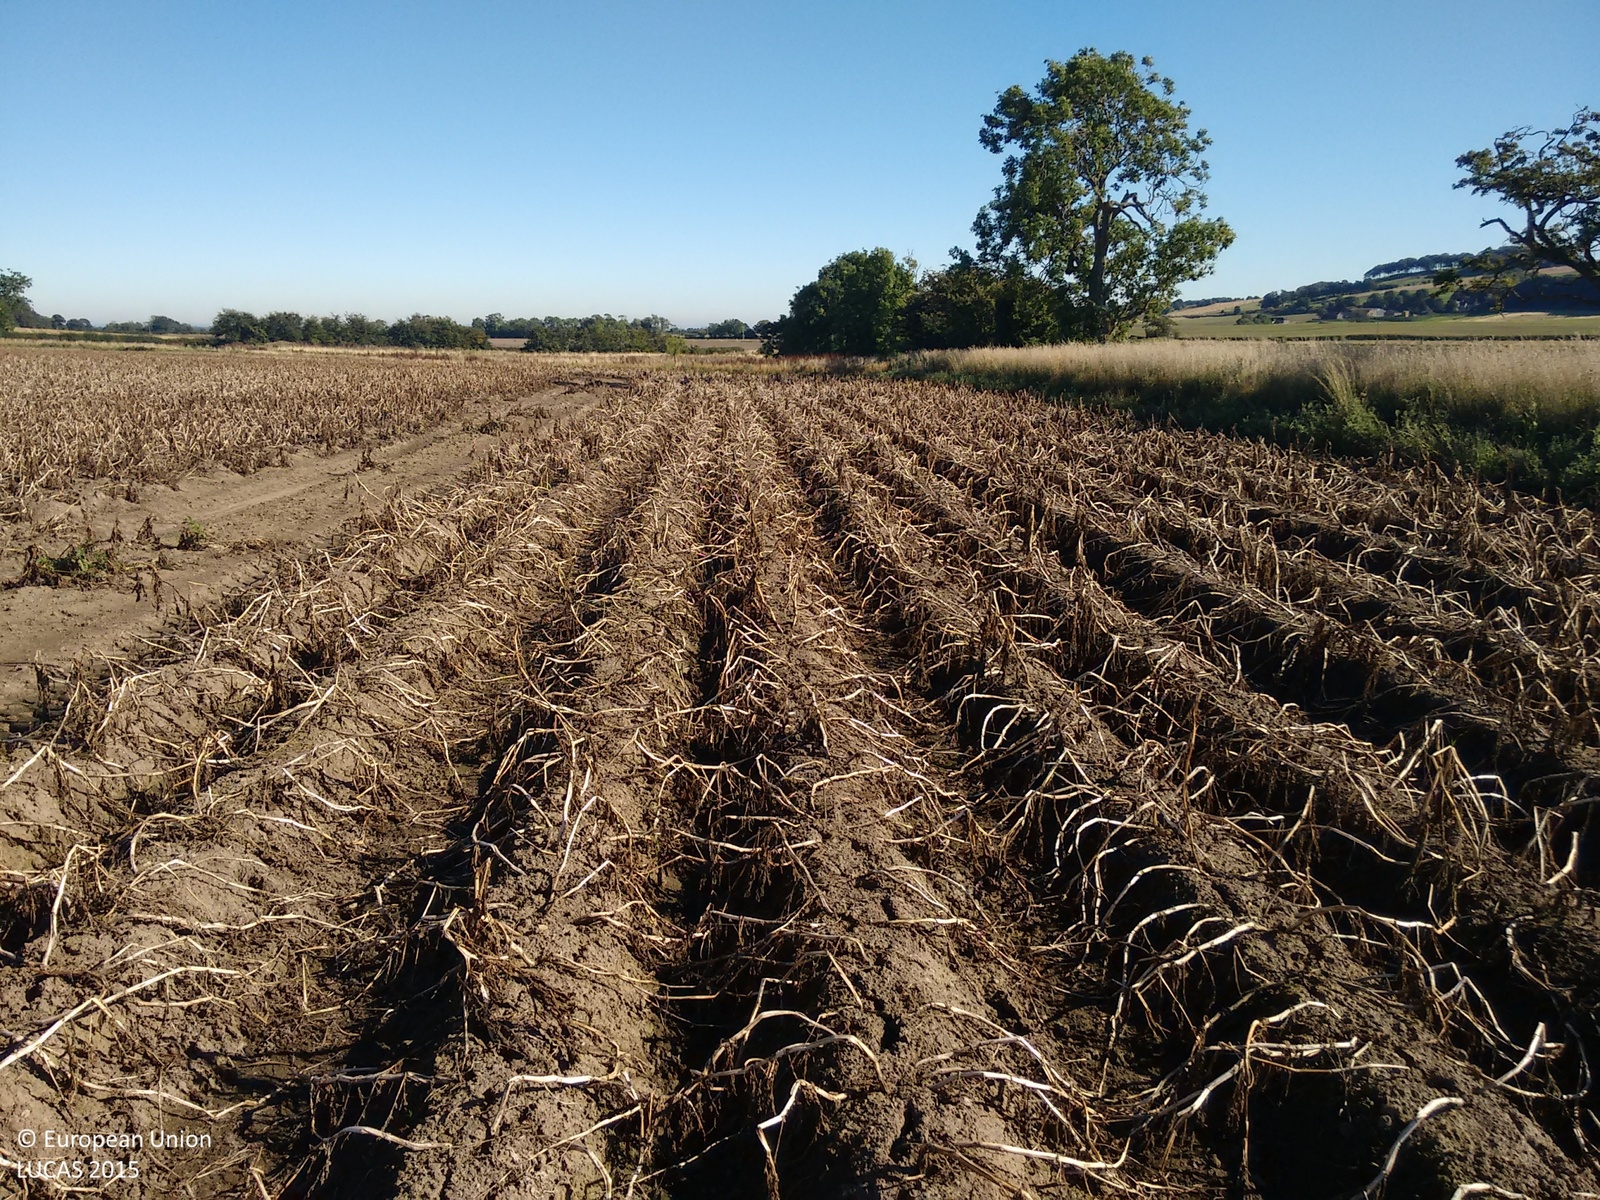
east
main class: Cropland
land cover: Potatoes
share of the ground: > 75 %
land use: Agriculture (excluding fallow land and kitchen gardens)
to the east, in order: Potatoes; Grassland without tree/shrub cover; Fences; Lines of trees; Ditches and canals; Grass margins; Fences; Grass margins; Other bare soil
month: October
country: GB
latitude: 56.6984
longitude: -2.5503
